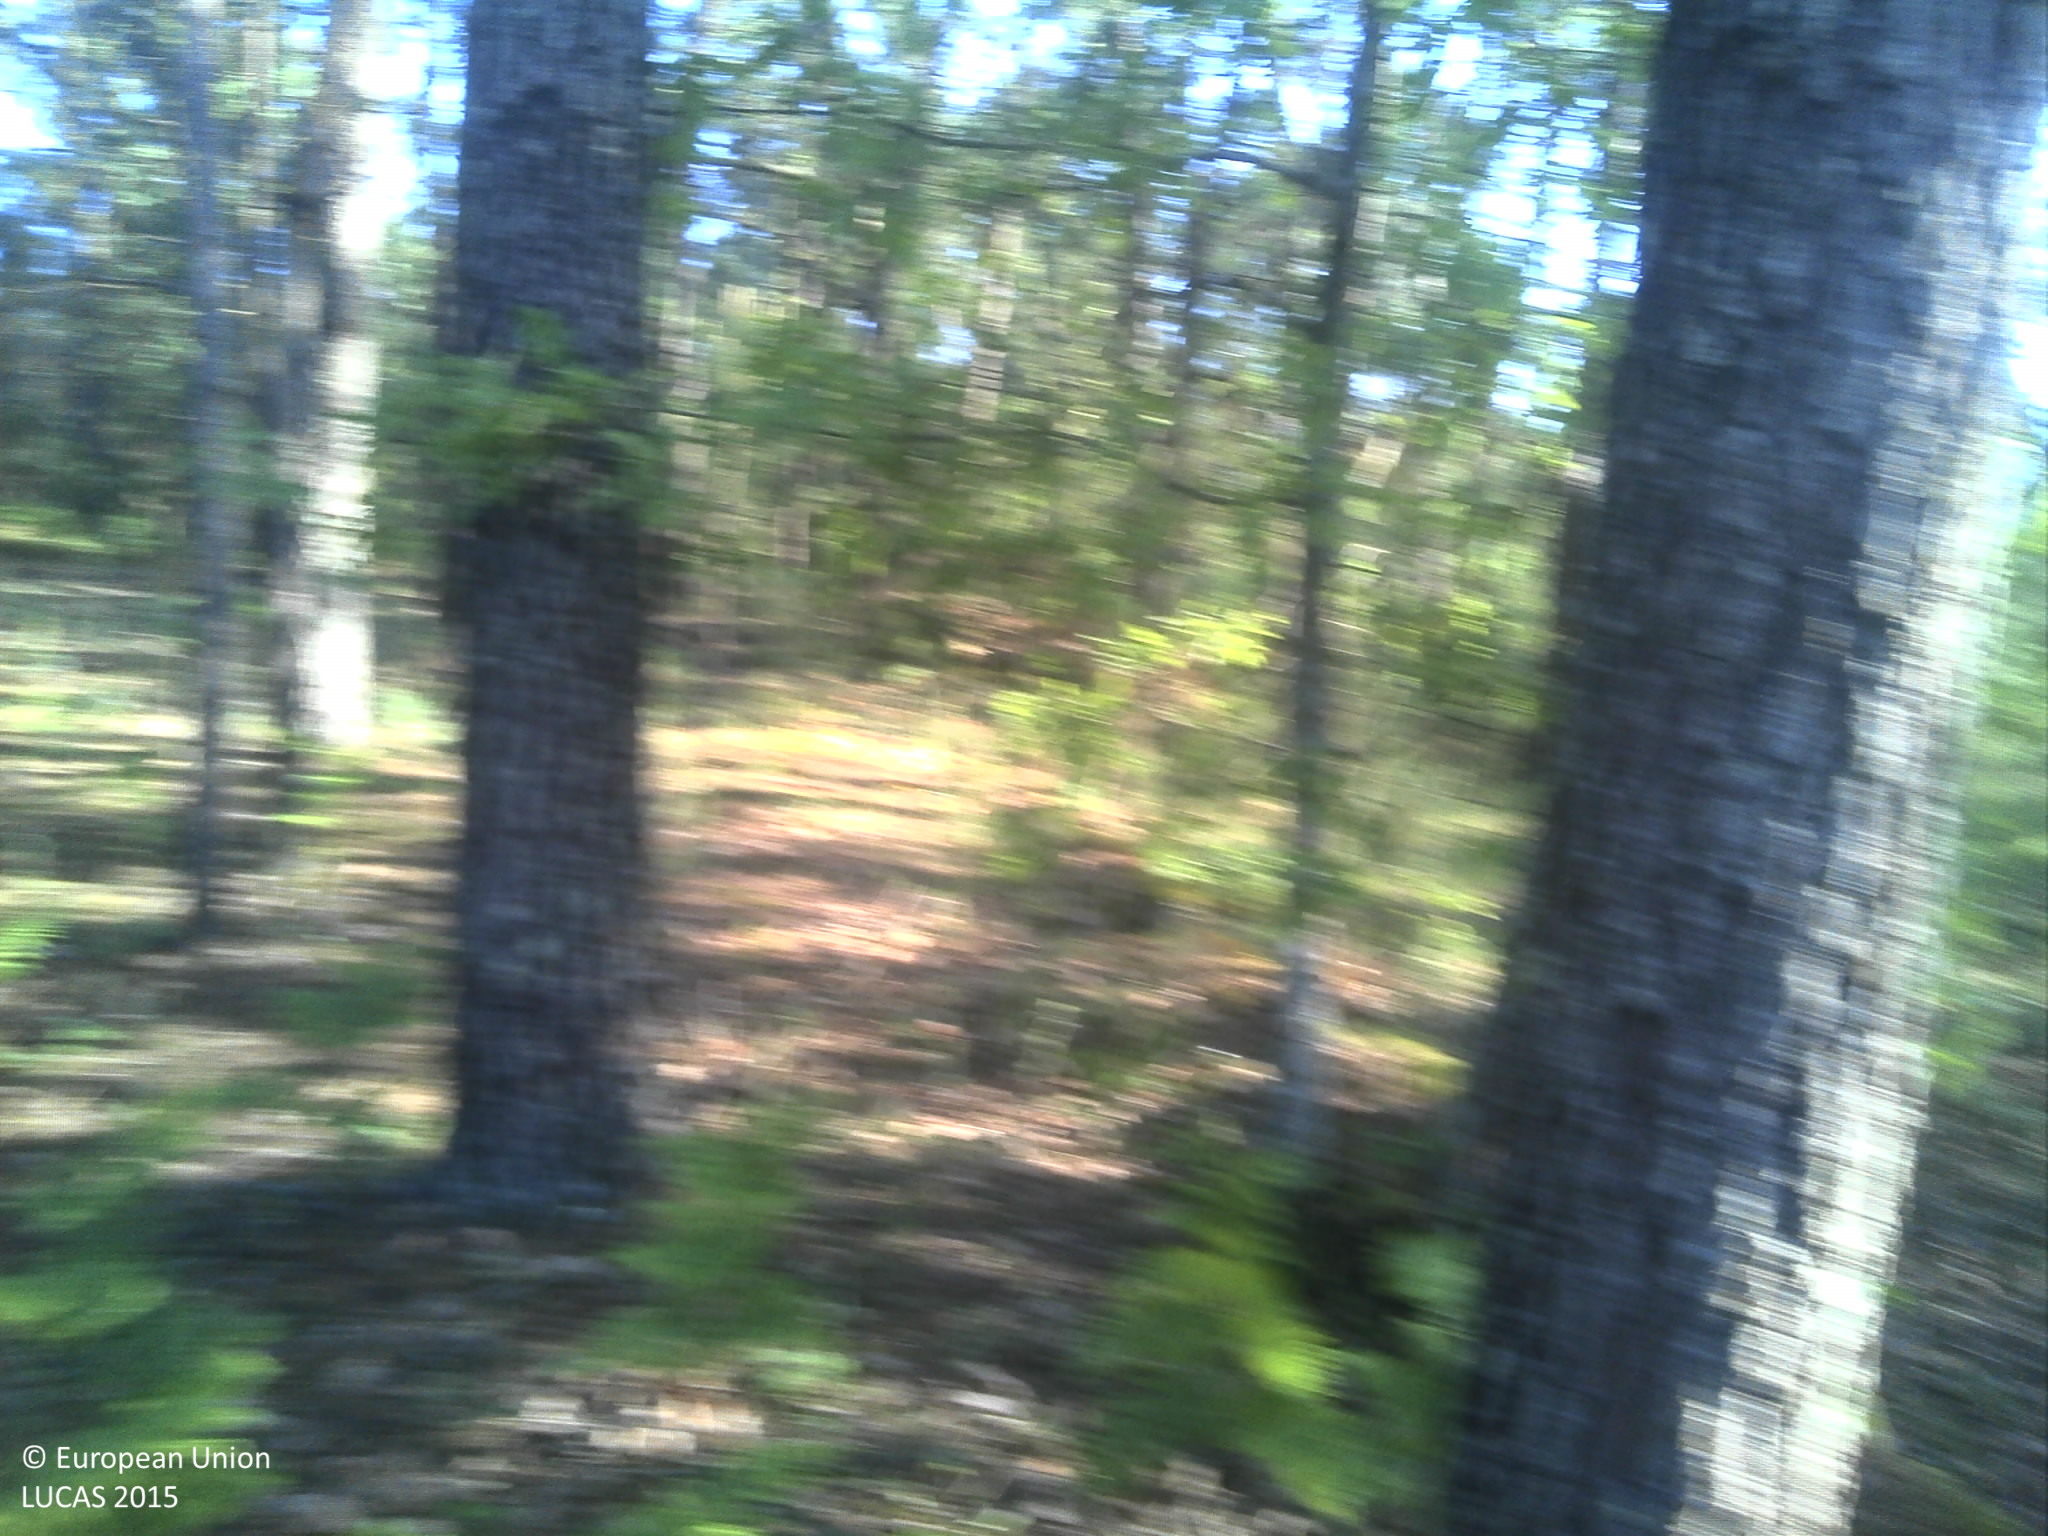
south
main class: Woodland
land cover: Pine dominated coniferous woodland
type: coniferous forest of the mediterranean region
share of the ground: 50 - 75 %
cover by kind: coniferous forest trees 100 %
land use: Forestry
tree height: > 5 m
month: May
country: PT
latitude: 40.6424
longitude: -7.7749
